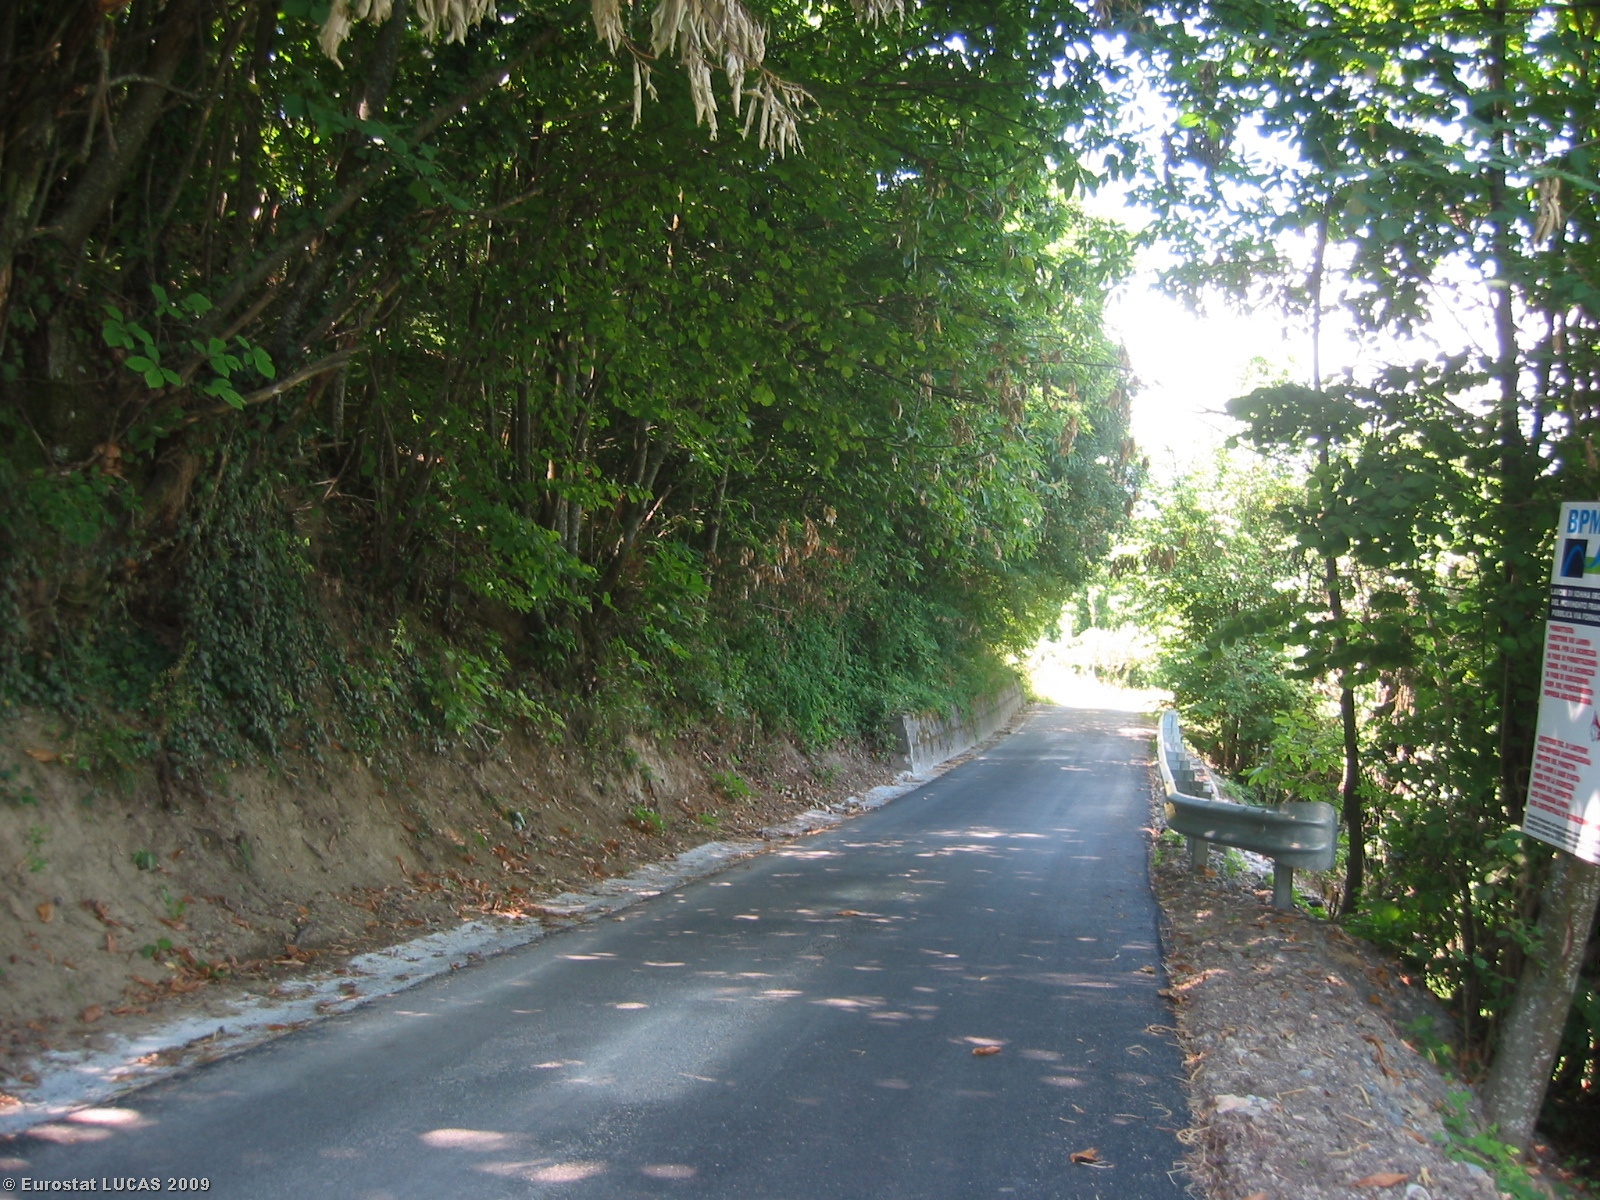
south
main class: Woodland
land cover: Broadleaved woodland
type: mesophytic deciduous forest
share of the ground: > 75 %
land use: Forestry
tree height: > 5 m
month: June
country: IT
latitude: 44.3293
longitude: 10.8132
